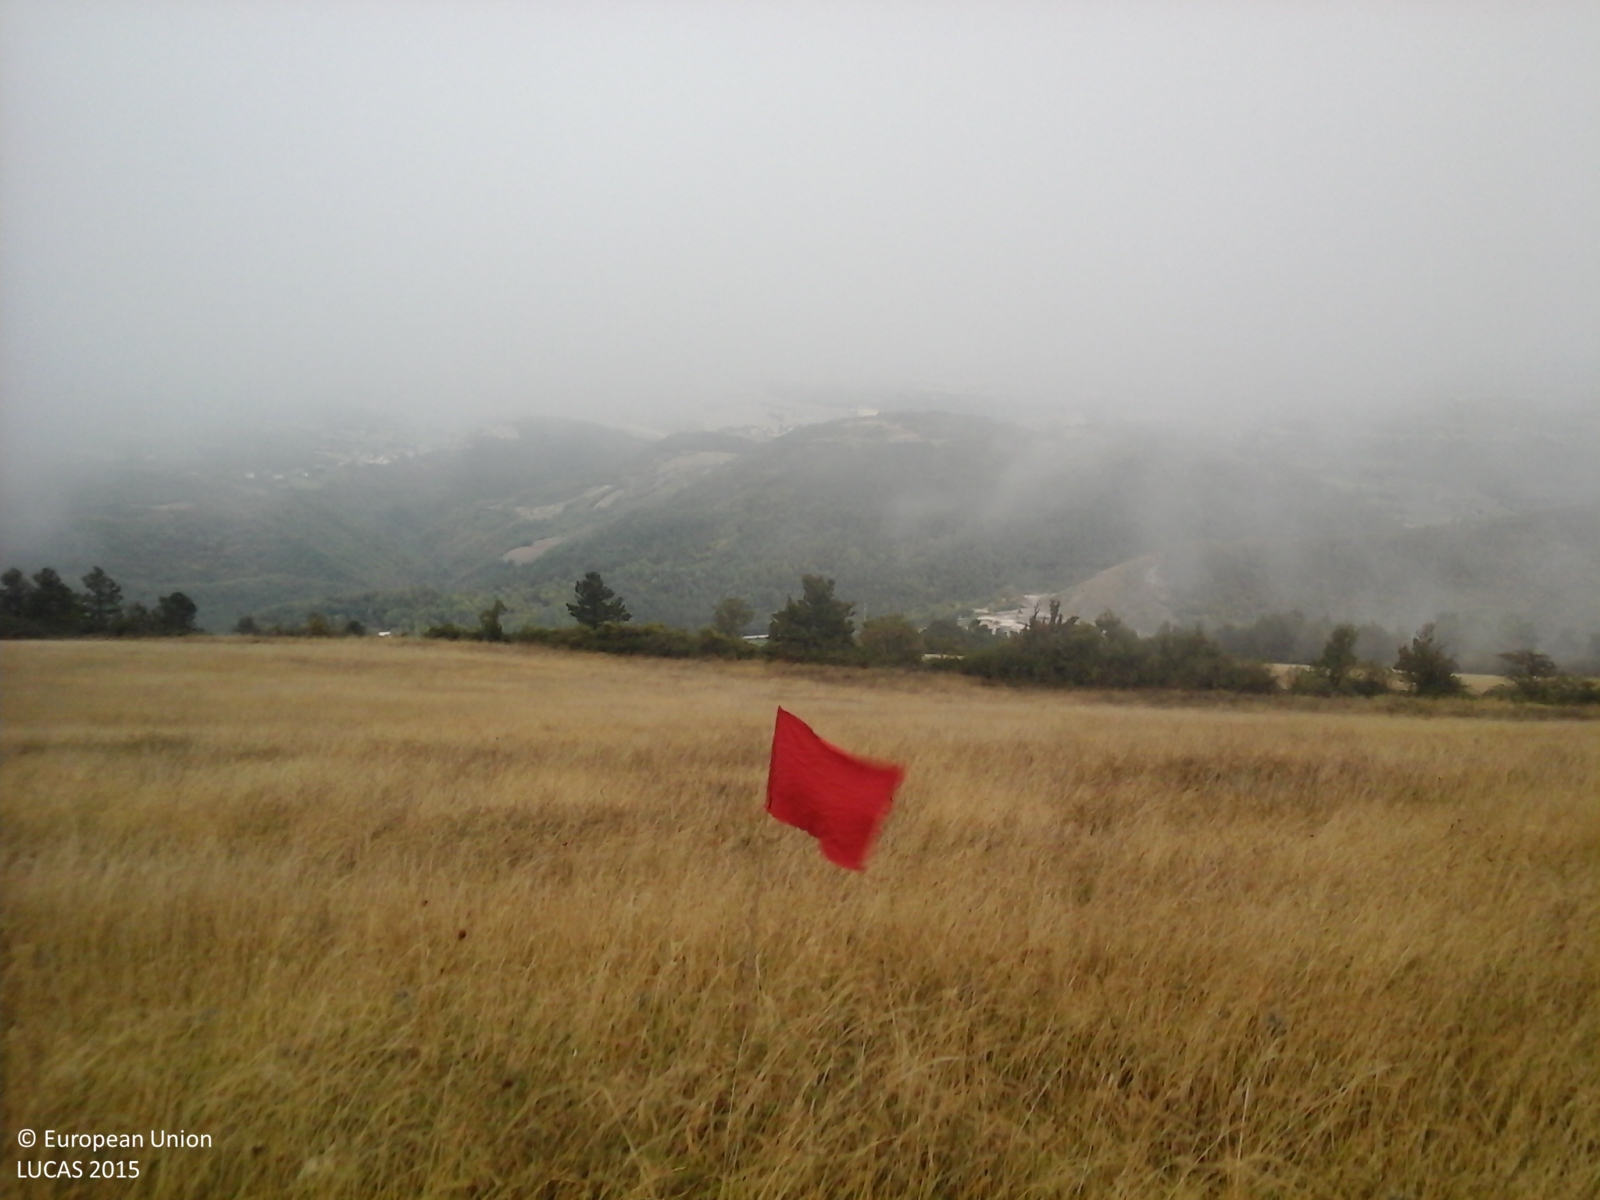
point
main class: Grassland
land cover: Grassland without tree/shrub cover
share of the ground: > 75 %
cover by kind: herbaceous plants 100 %
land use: Agriculture (excluding fallow land and kitchen gardens)
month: September
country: IT
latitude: 43.4408
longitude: 12.9947
